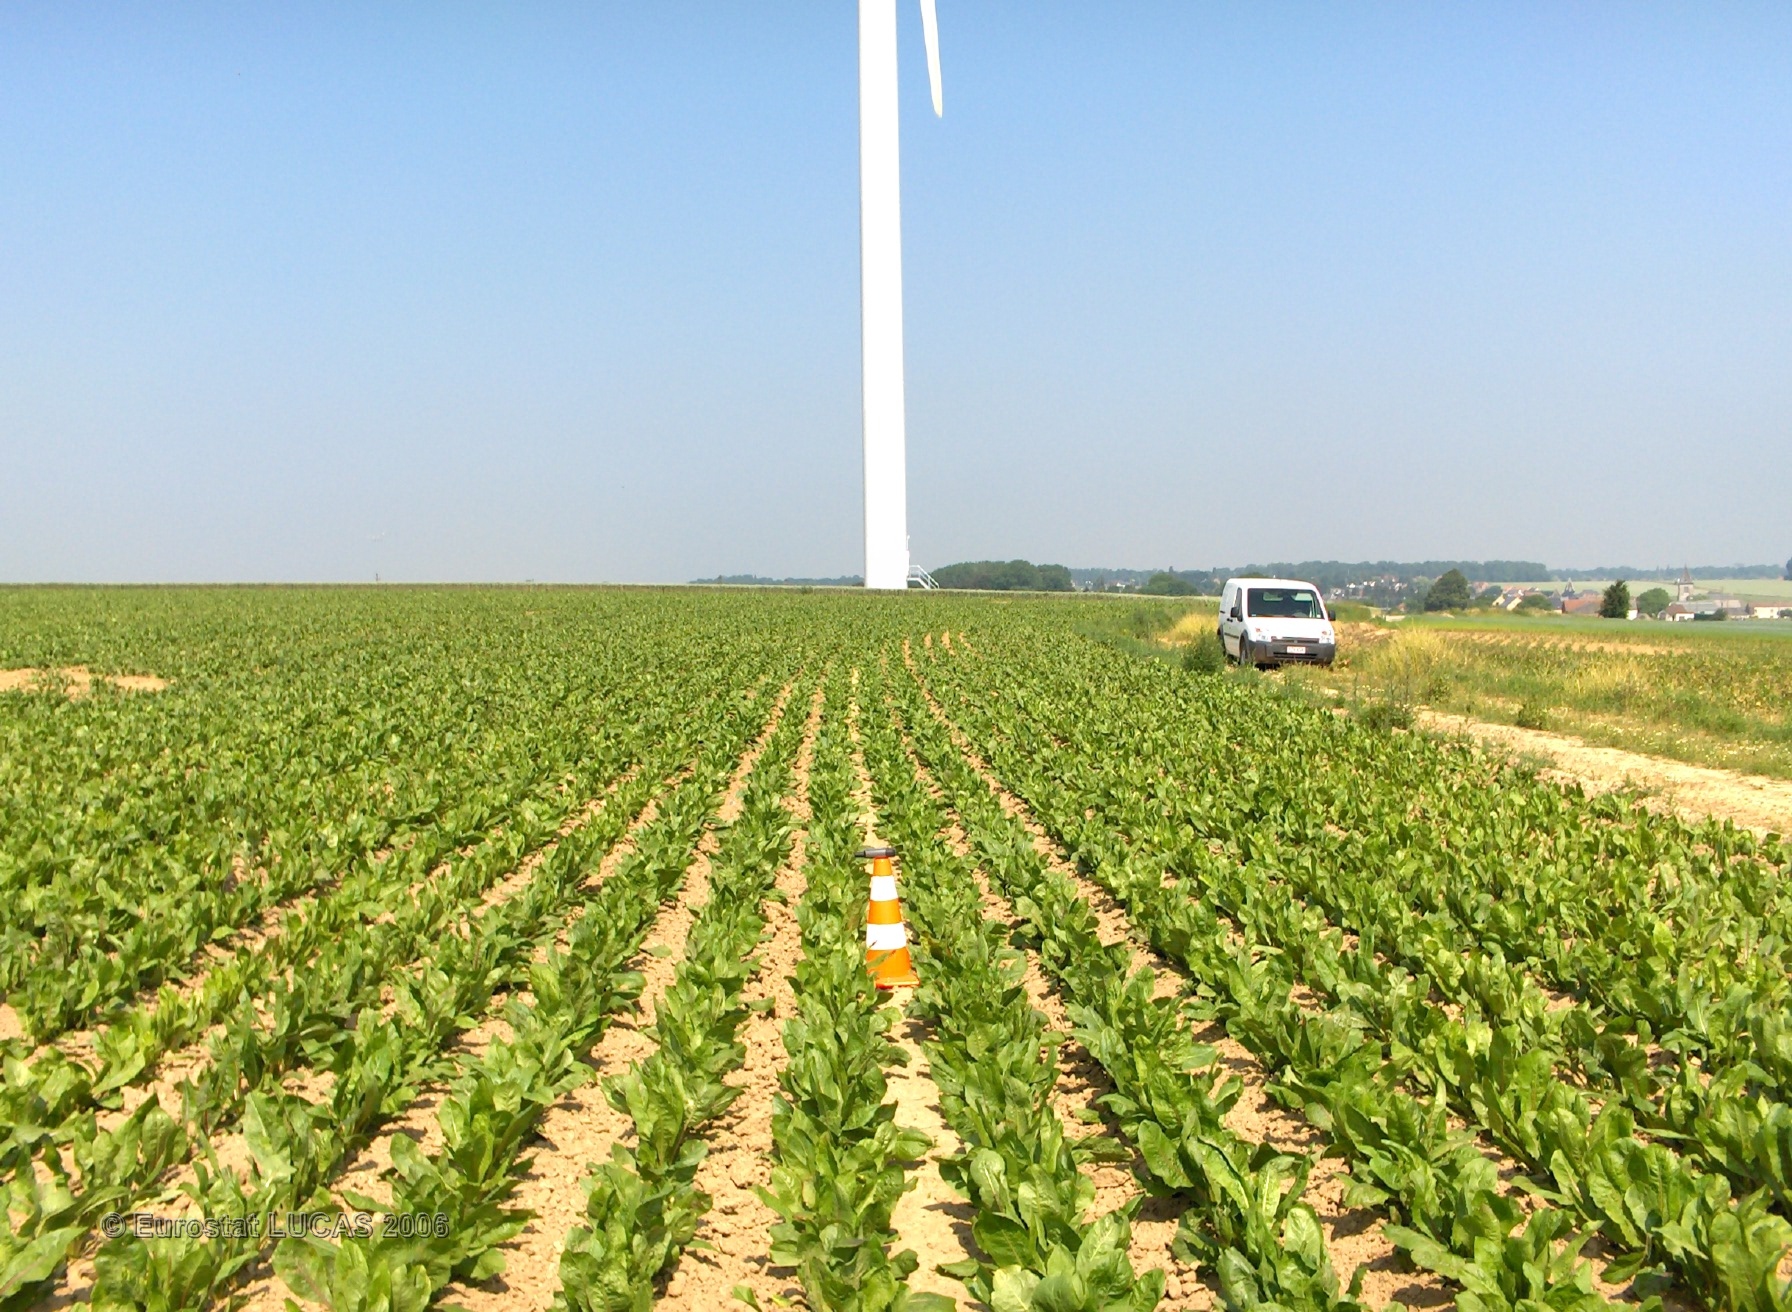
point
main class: Cropland
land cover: Other non-permanent industrial crops
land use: Agriculture (excluding fallow land and kitchen gardens)
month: June
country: BE
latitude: 50.3042
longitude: 4.5062
